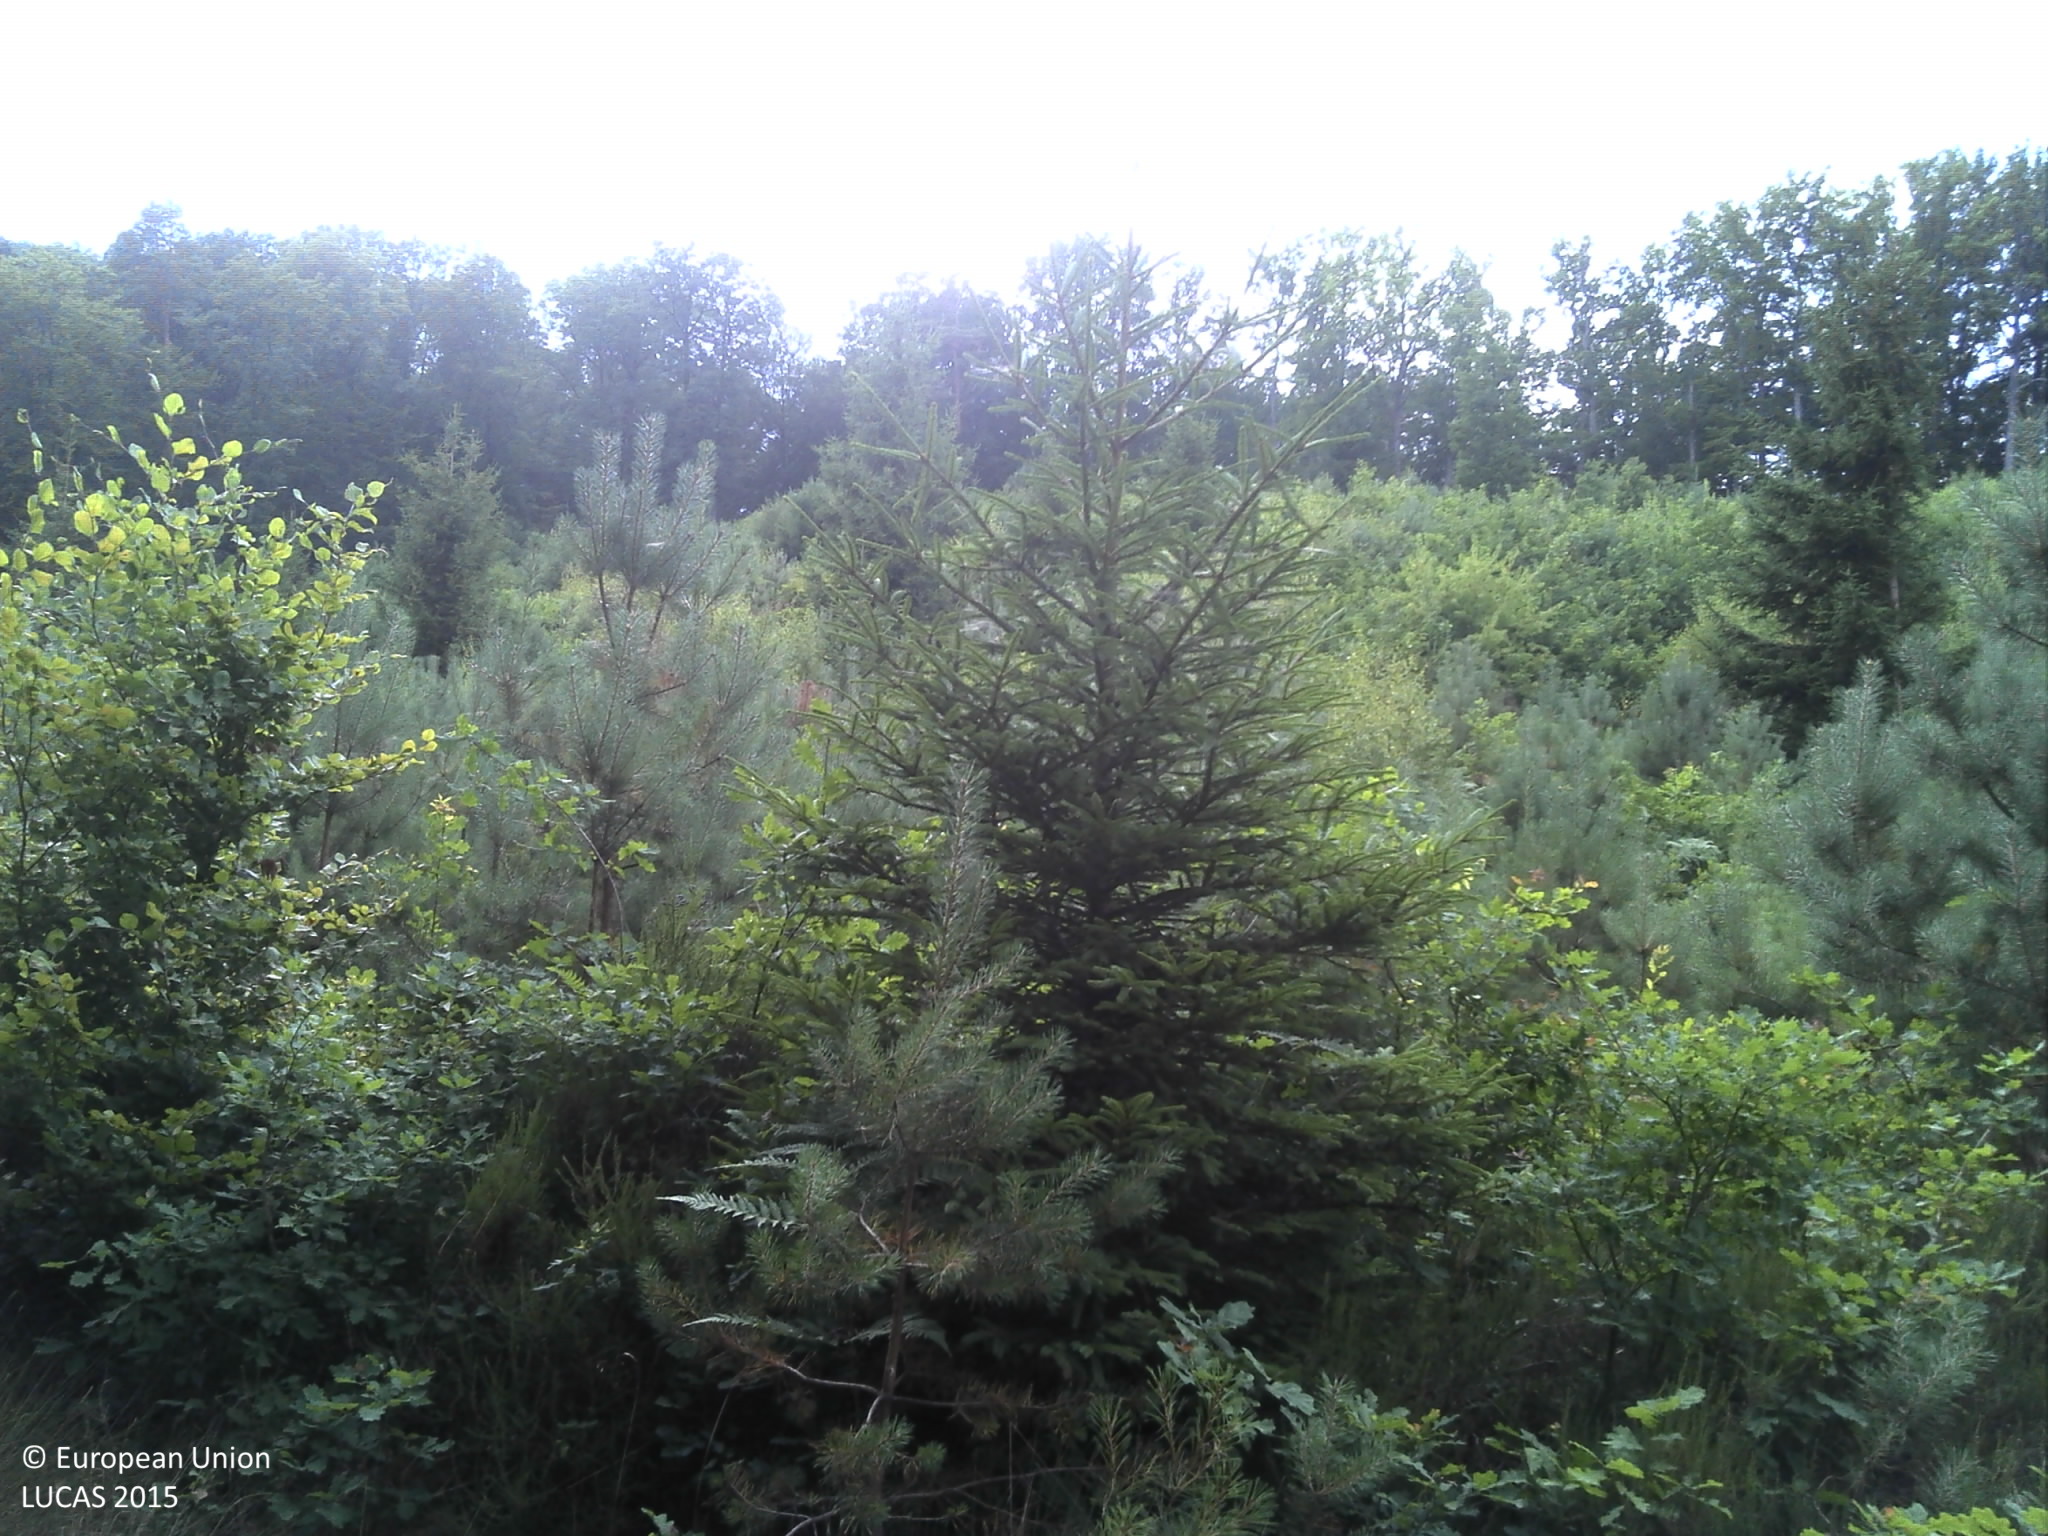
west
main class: Woodland
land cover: Spruce dominated coniferous woodland
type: hemiboreal forest and nemoral coniferous forest and mixed broadleaved-coniferous forest
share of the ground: > 75 %
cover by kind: coniferous forest trees 90 %, broadleaved forest trees 10 %
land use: Forestry
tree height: > 5 m
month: July
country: FR
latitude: 49.0052
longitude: 7.4989
